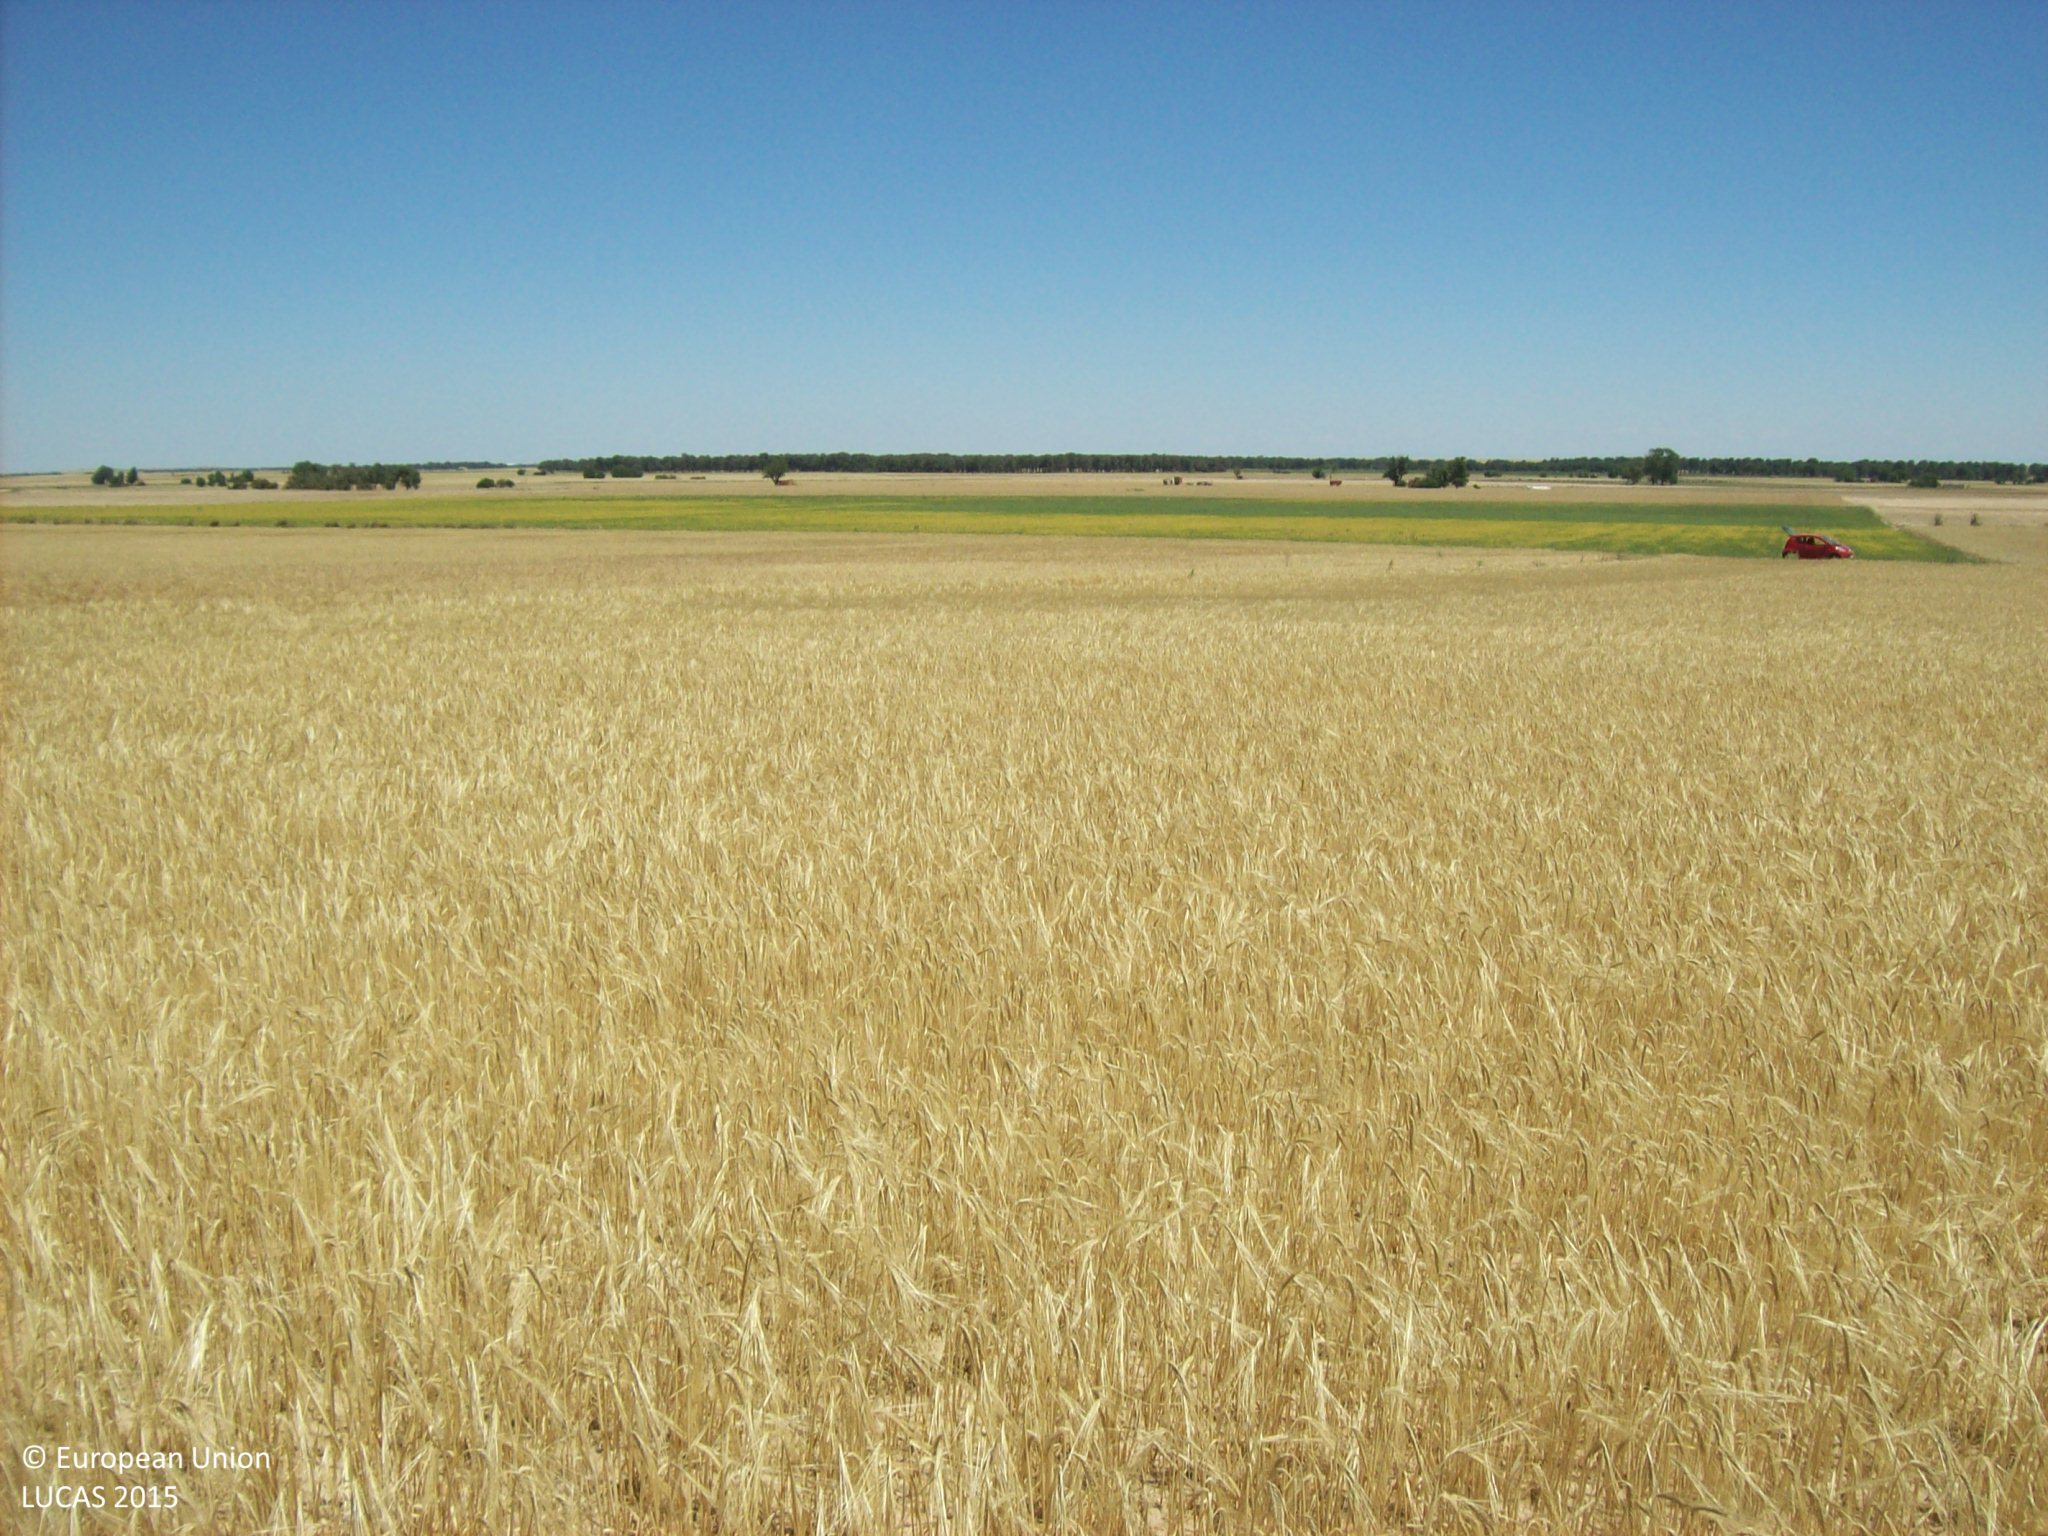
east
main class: Cropland
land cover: Barley
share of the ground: > 75 %
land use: Agriculture (excluding fallow land and kitchen gardens)
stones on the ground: < 10 %
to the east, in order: Barley; Grass margins; Barley; Grass margins; Tracks; Grass margins; Dry pulses
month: June
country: ES
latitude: 41.2011
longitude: -5.2287
